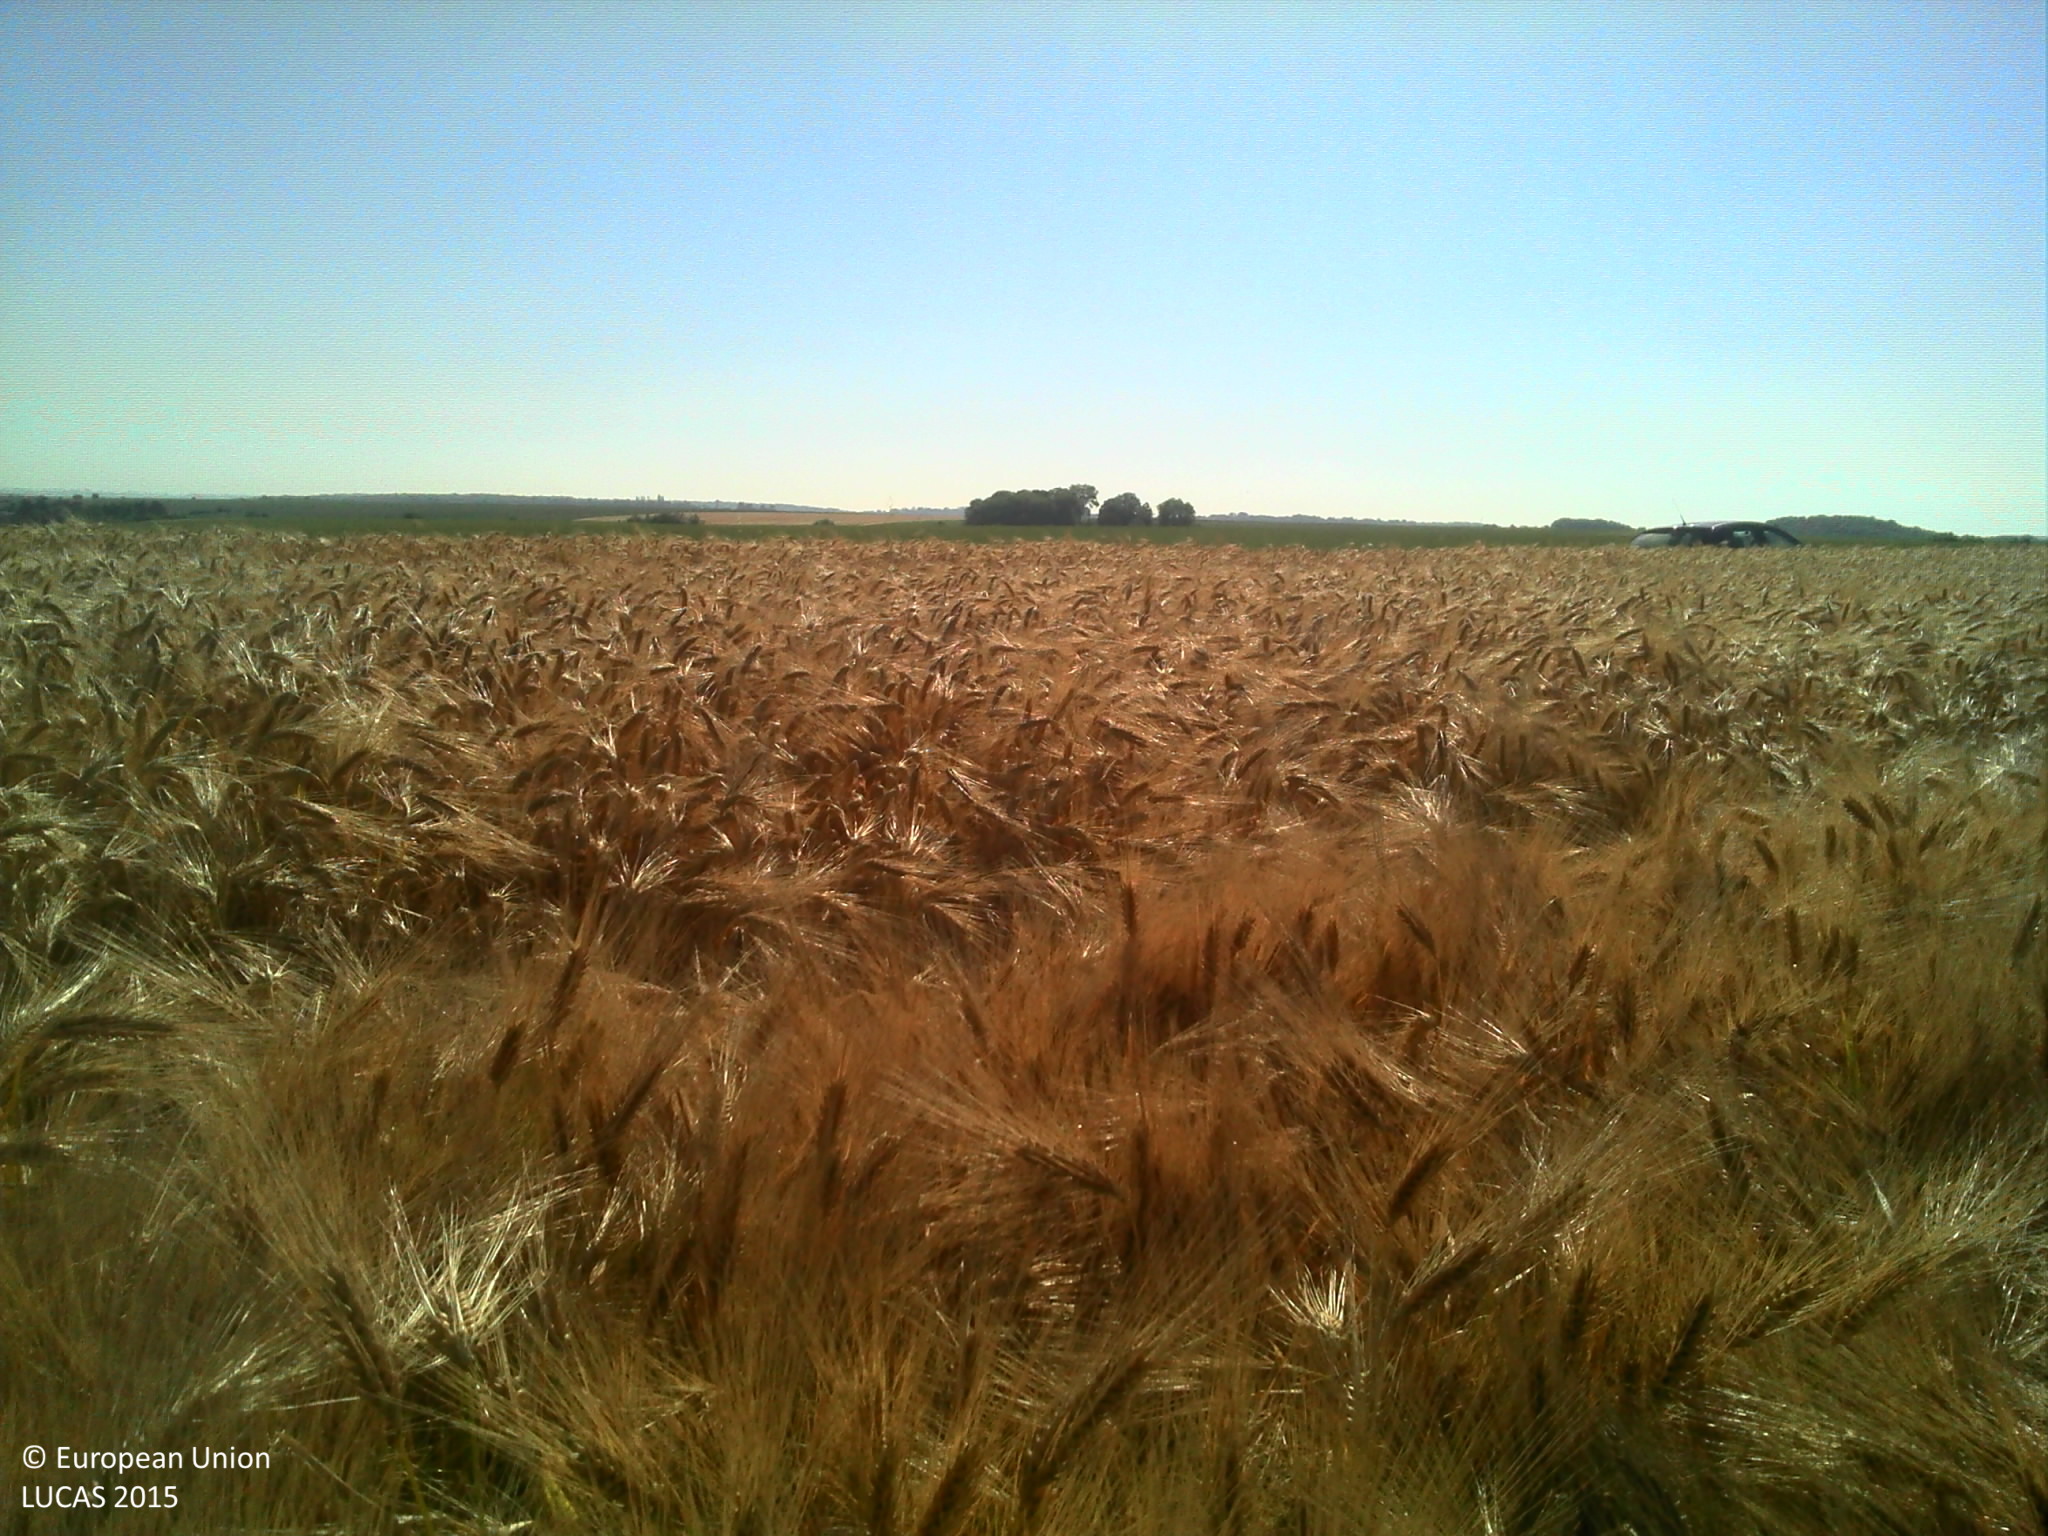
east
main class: Cropland
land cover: Barley
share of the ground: > 75 %
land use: Agriculture (excluding fallow land and kitchen gardens)
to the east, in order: Barley; Grass margins; Tracks; Grass margins; Common wheat
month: June
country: FR
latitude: 49.7777
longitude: 2.2792
